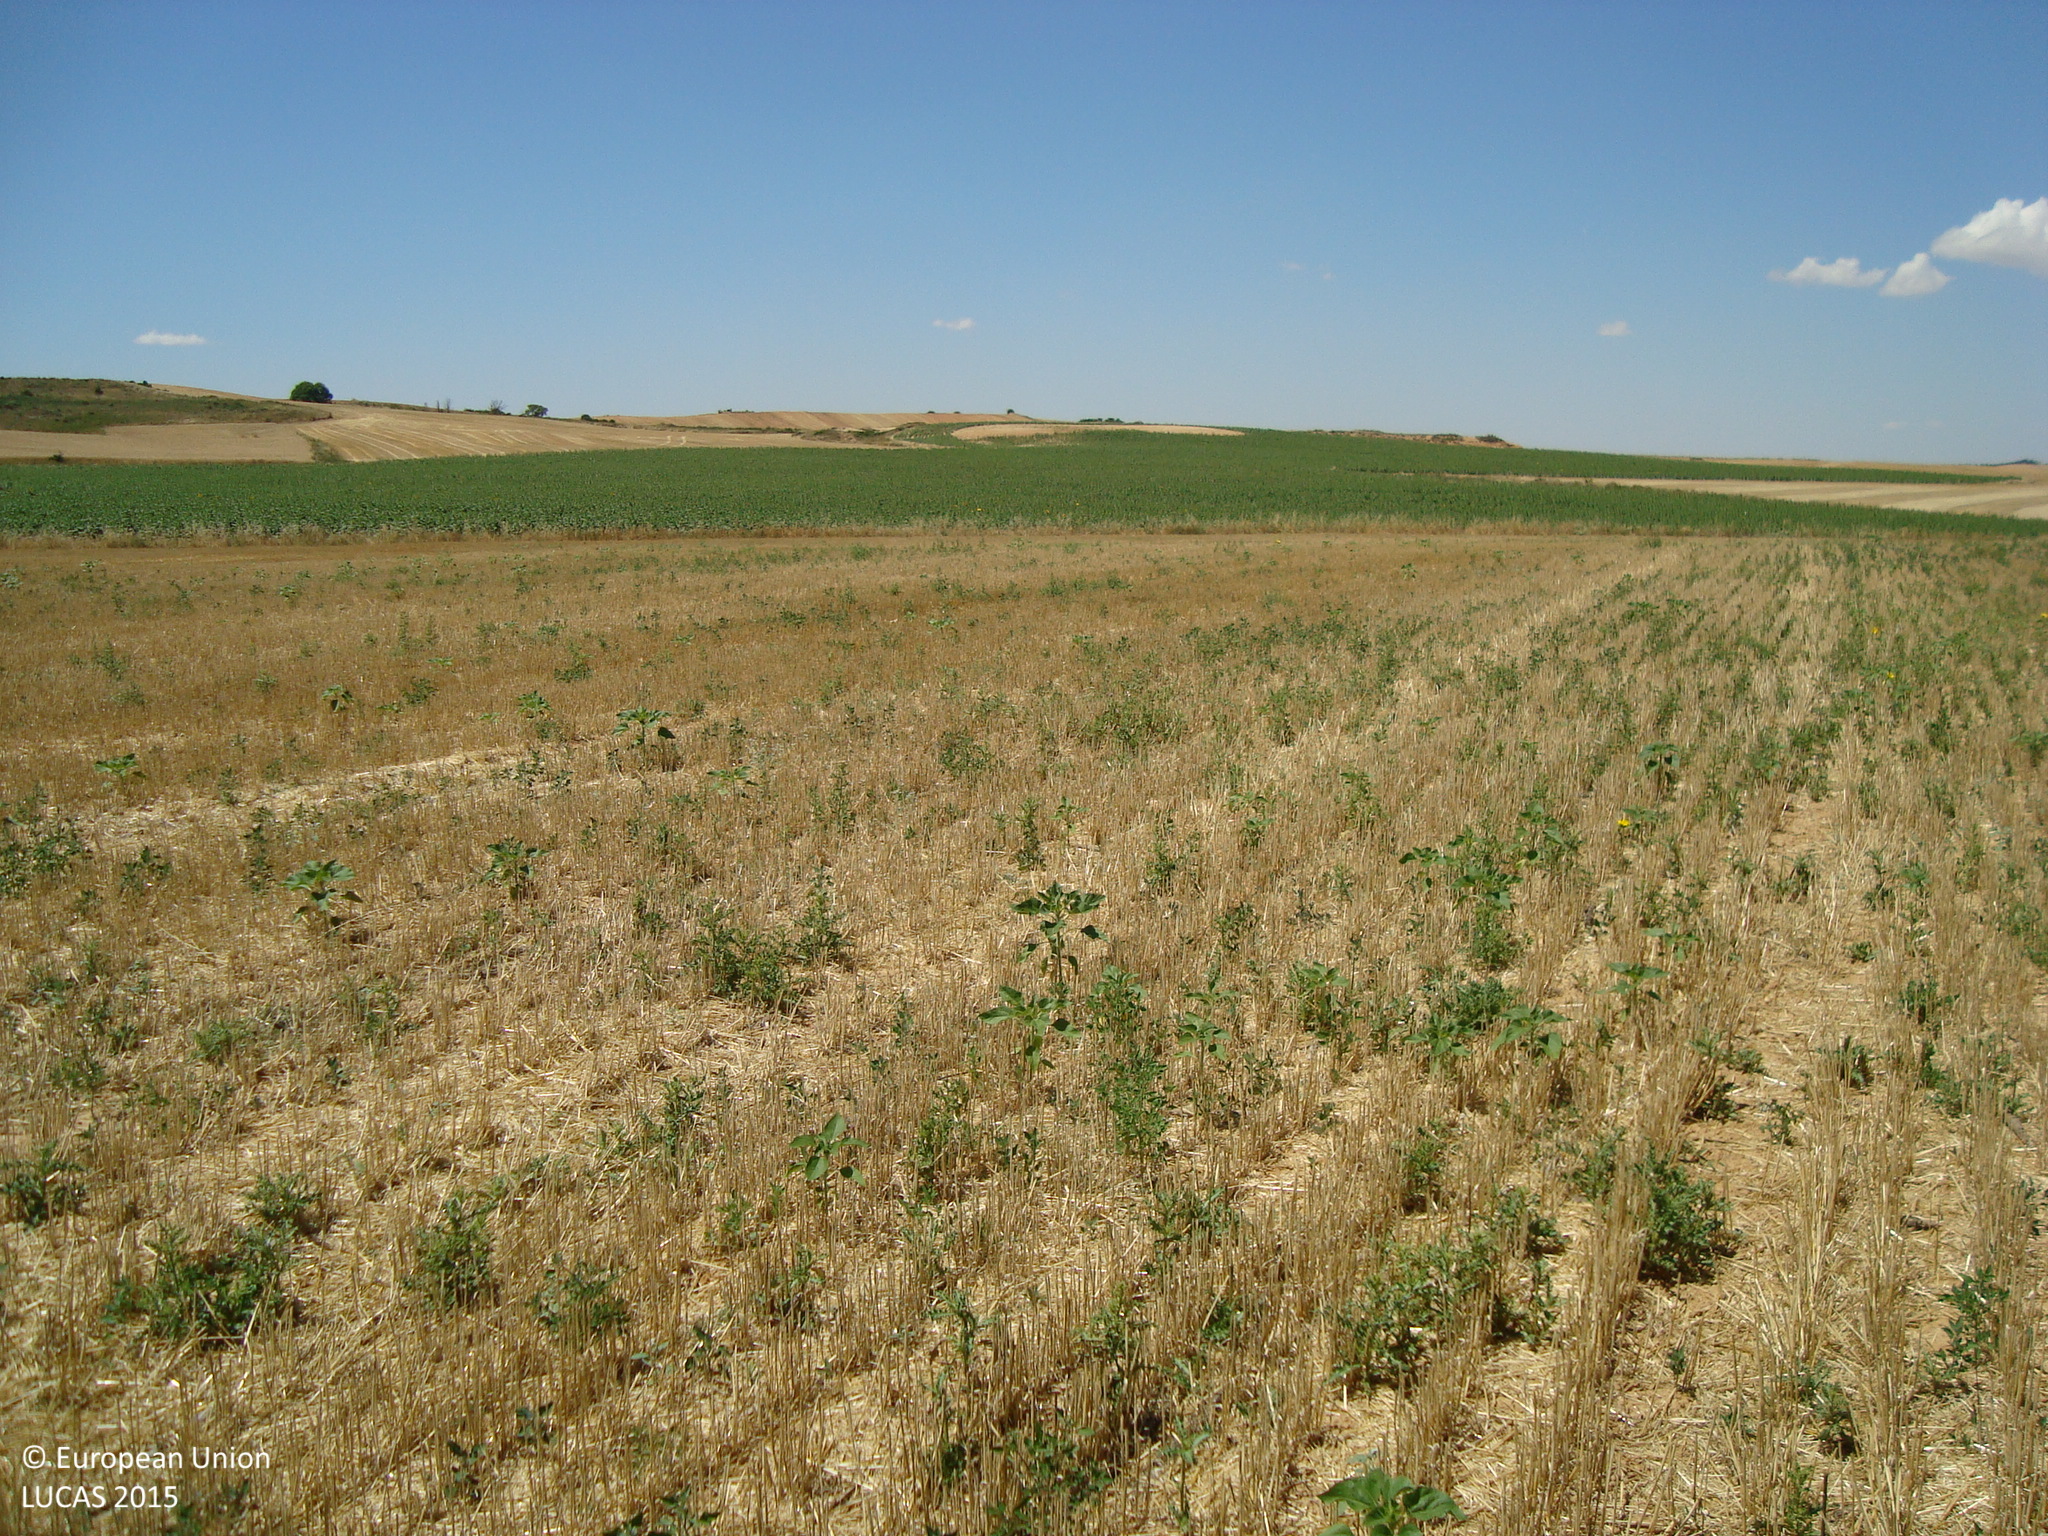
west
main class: Cropland
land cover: Barley
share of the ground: > 75 %
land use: Agriculture (excluding fallow land and kitchen gardens)
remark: Harvested field
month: July
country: ES
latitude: 41.8559
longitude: -3.6295
